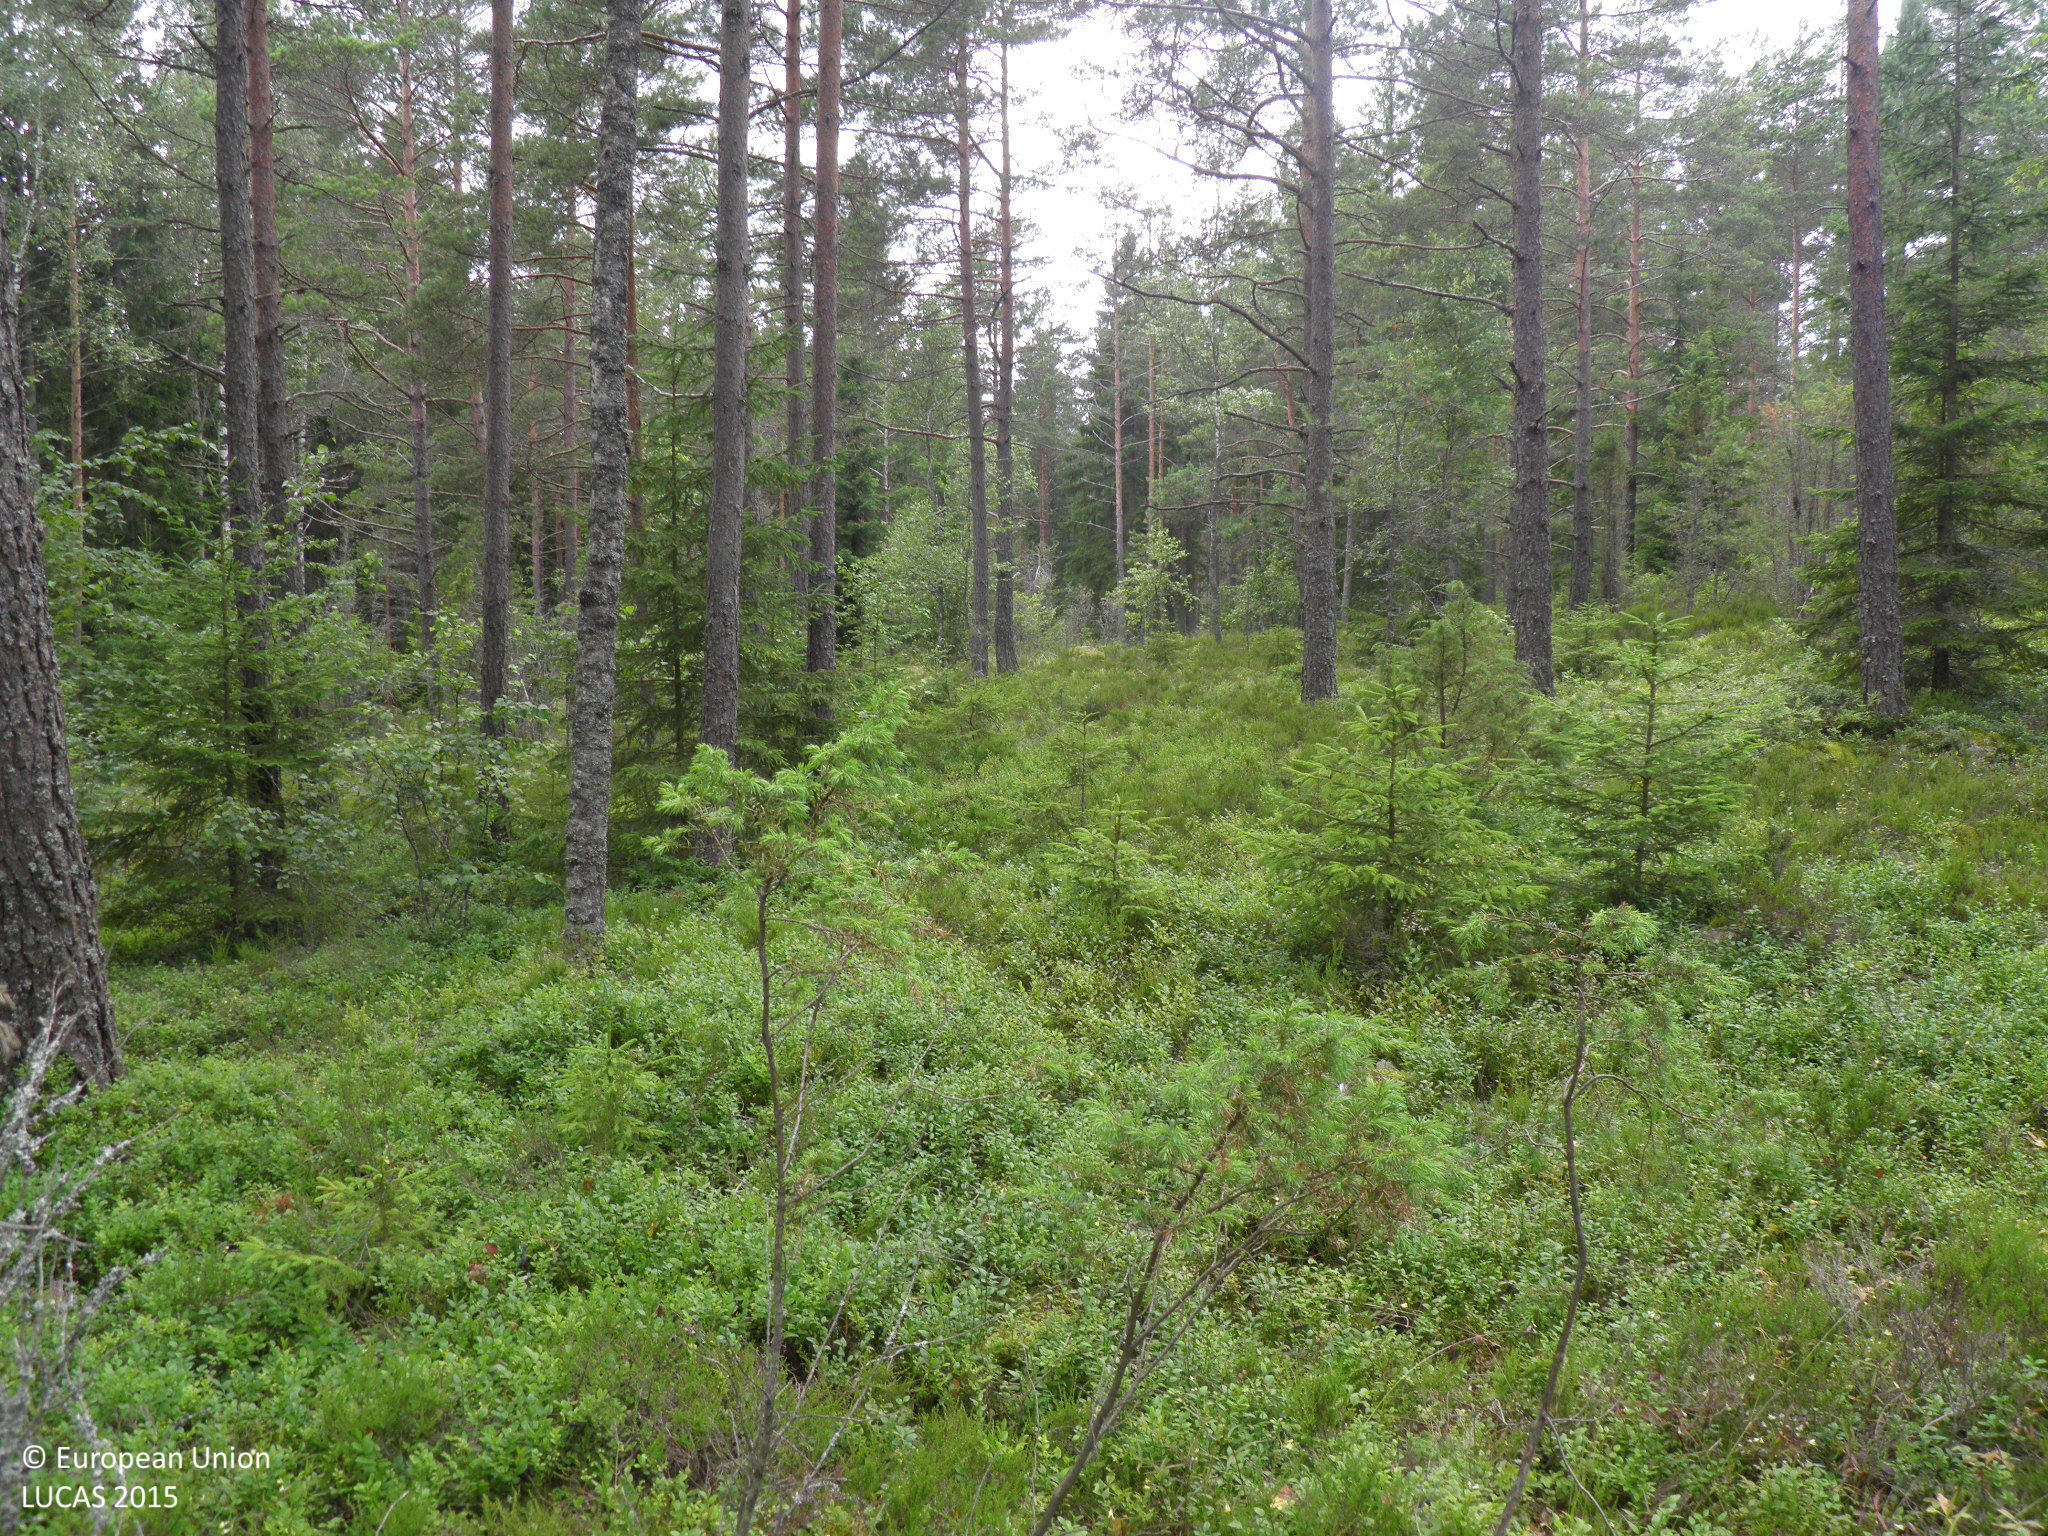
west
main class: Woodland
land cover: Pine dominated coniferous woodland
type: hemiboreal forest and nemoral coniferous forest and mixed broadleaved-coniferous forest
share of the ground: 25 - 50 %
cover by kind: shrubs 50 %, coniferous forest trees 25 %, herbaceous plants 20 %, broadleaved forest trees 5 %
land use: Forestry
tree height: > 5 m
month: July
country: FI
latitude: 60.0487
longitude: 22.6266
